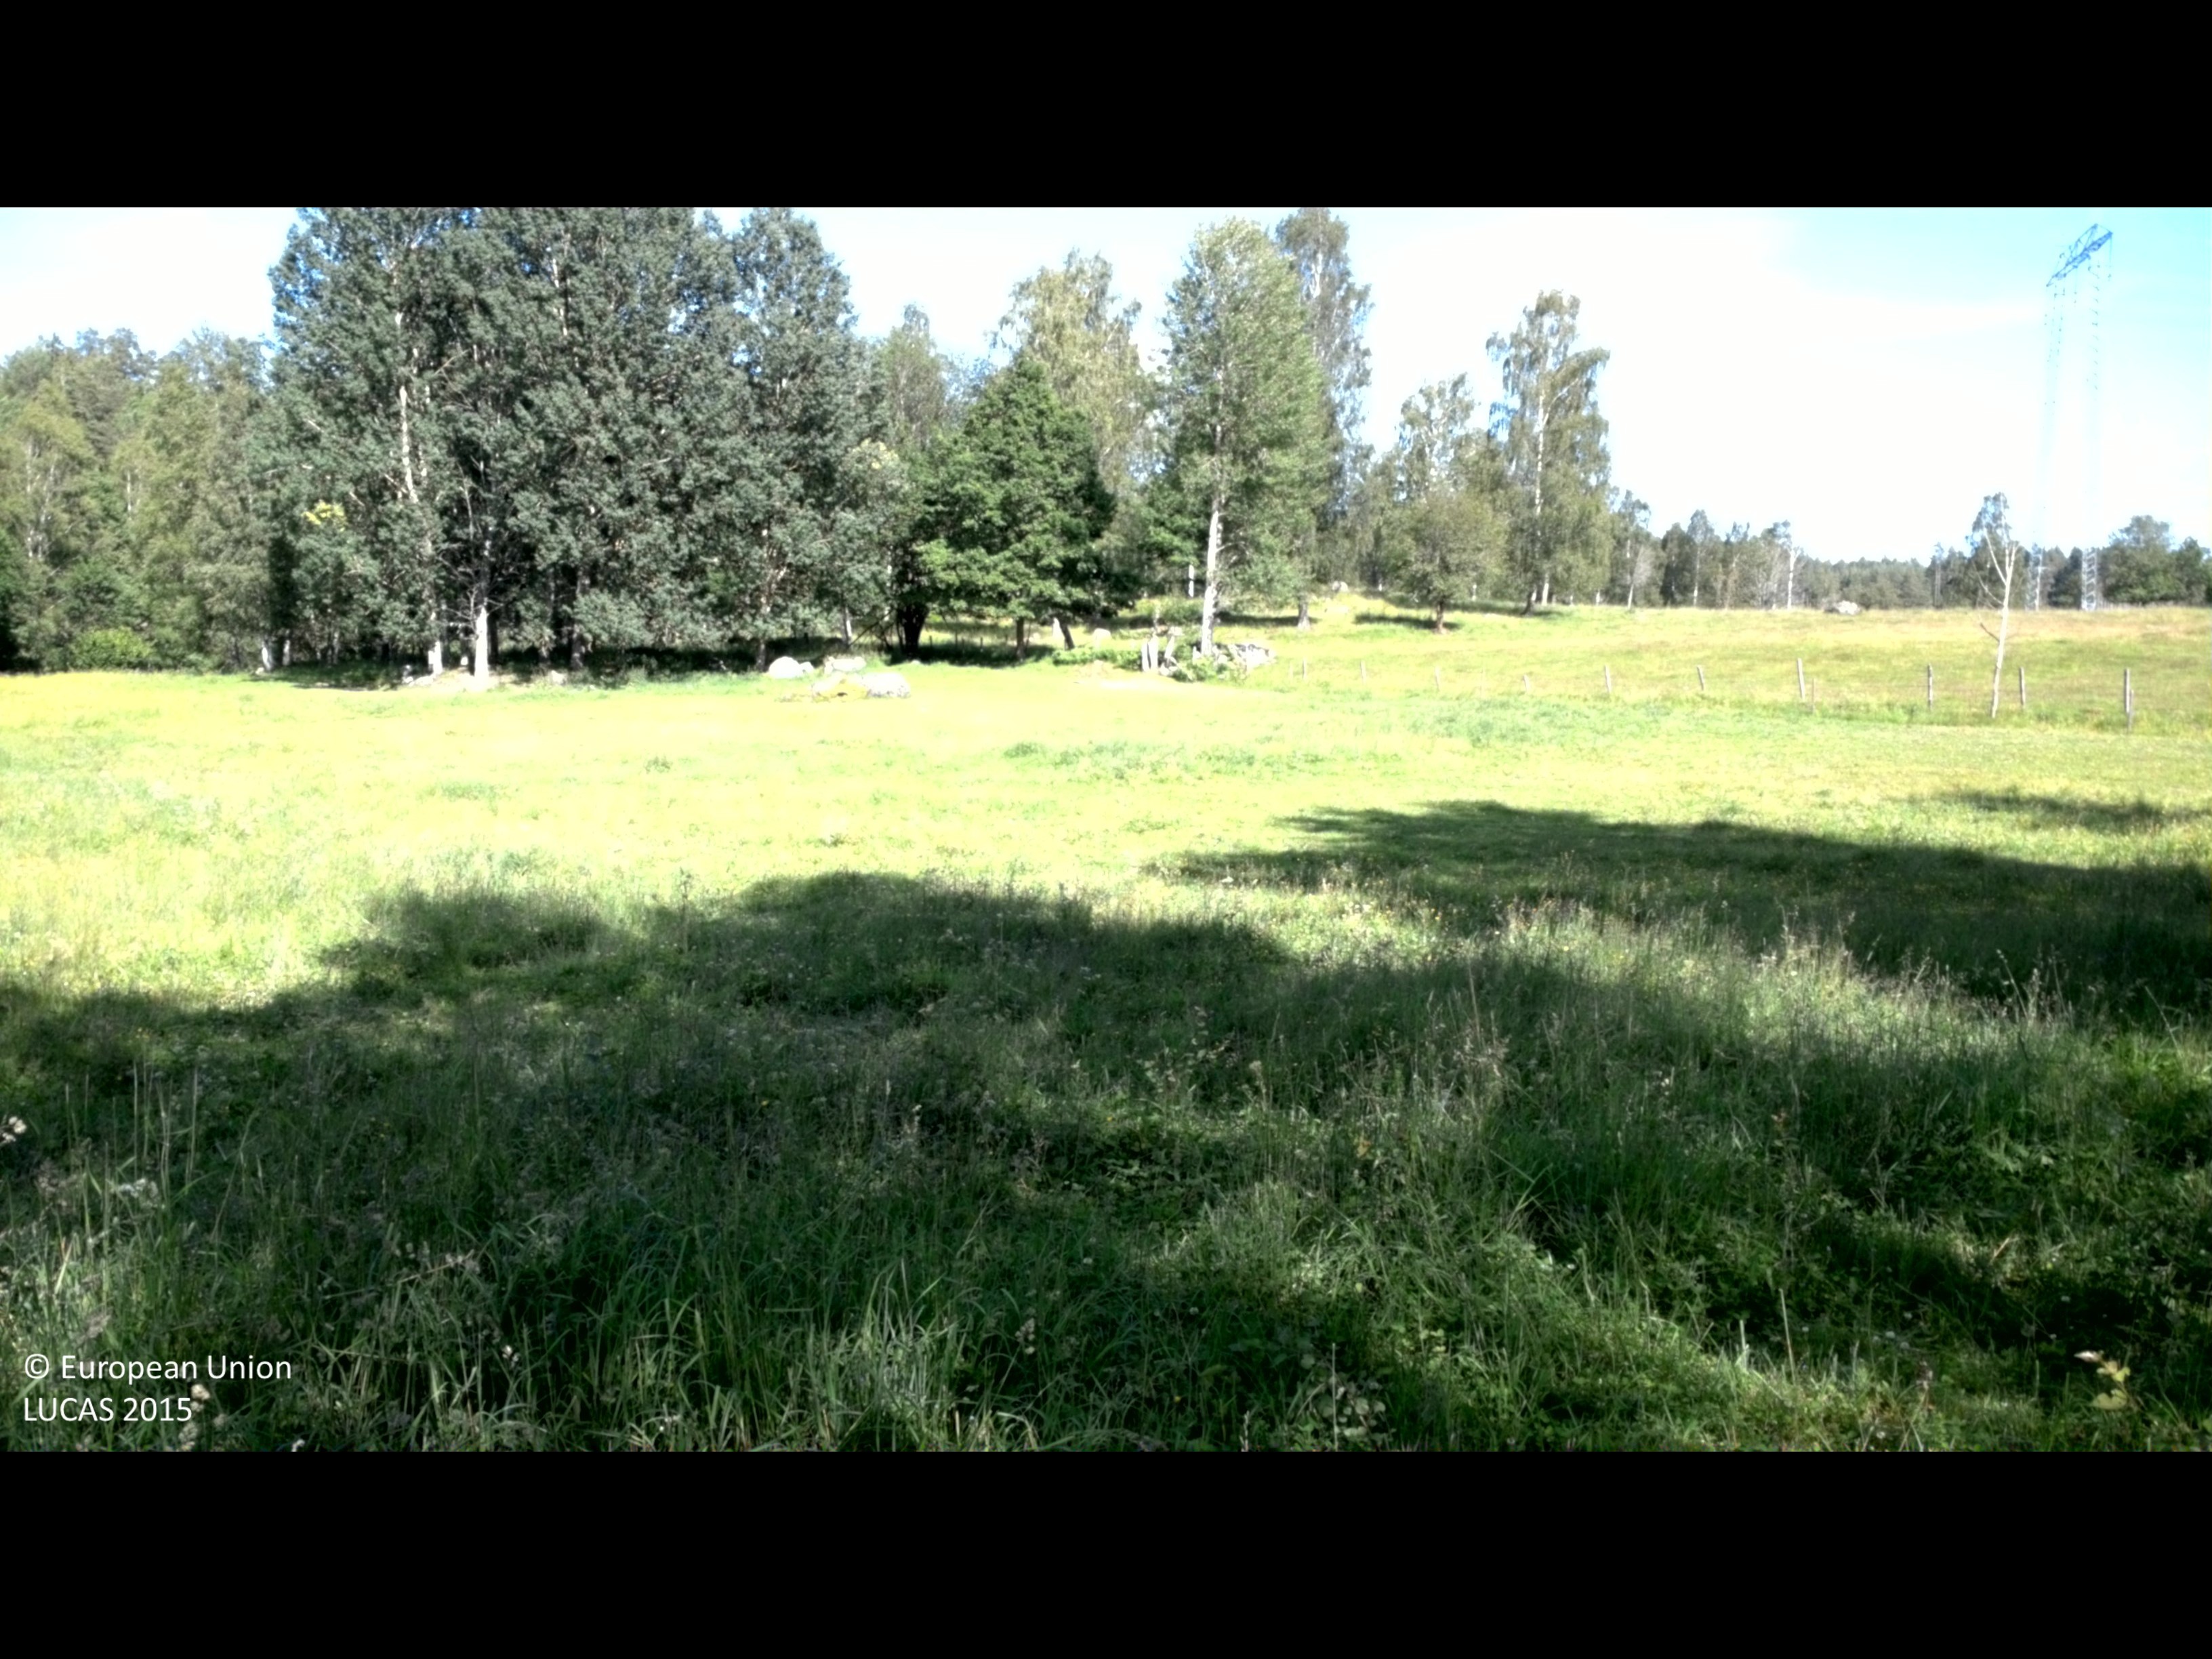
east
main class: Grassland
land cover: Grassland without tree/shrub cover
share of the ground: > 75 %
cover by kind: herbaceous plants 95 %, shrubs 5 %
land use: Agriculture (excluding fallow land and kitchen gardens)
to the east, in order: Grassland without tree/shrub cover; Fences; Grass margins; Fences; Broadleaved woodland; Grassland without tree/shrub cover; Electric lines; Grassland without tree/shrub cover; Broadleaved woodland; Rivers and streams; Broadleaved woodland
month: June
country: SE
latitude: 58.2040
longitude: 16.1731
